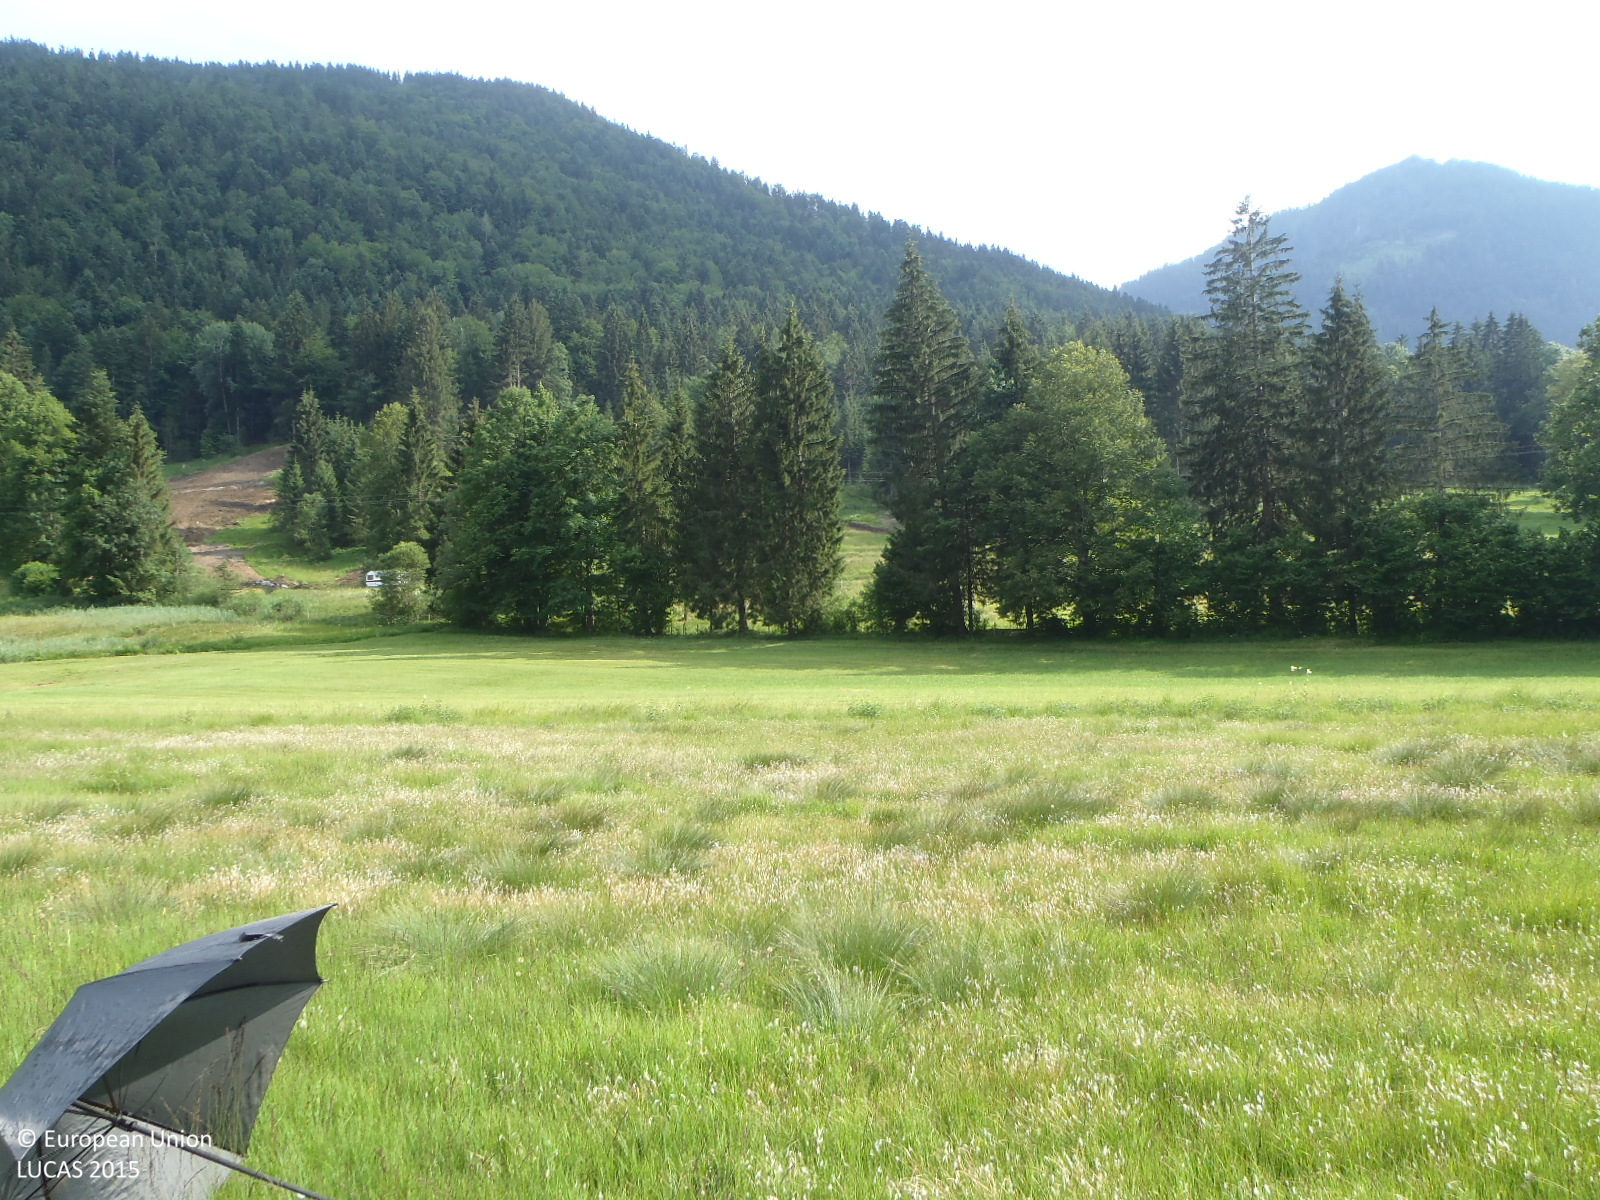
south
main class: Grassland
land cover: Grassland without tree/shrub cover
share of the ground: > 75 %
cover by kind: herbaceous plants 70 %, lichens and mosses 30 %
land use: Agriculture (excluding fallow land and kitchen gardens)
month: July
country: AT
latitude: 47.6408
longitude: 12.3279
